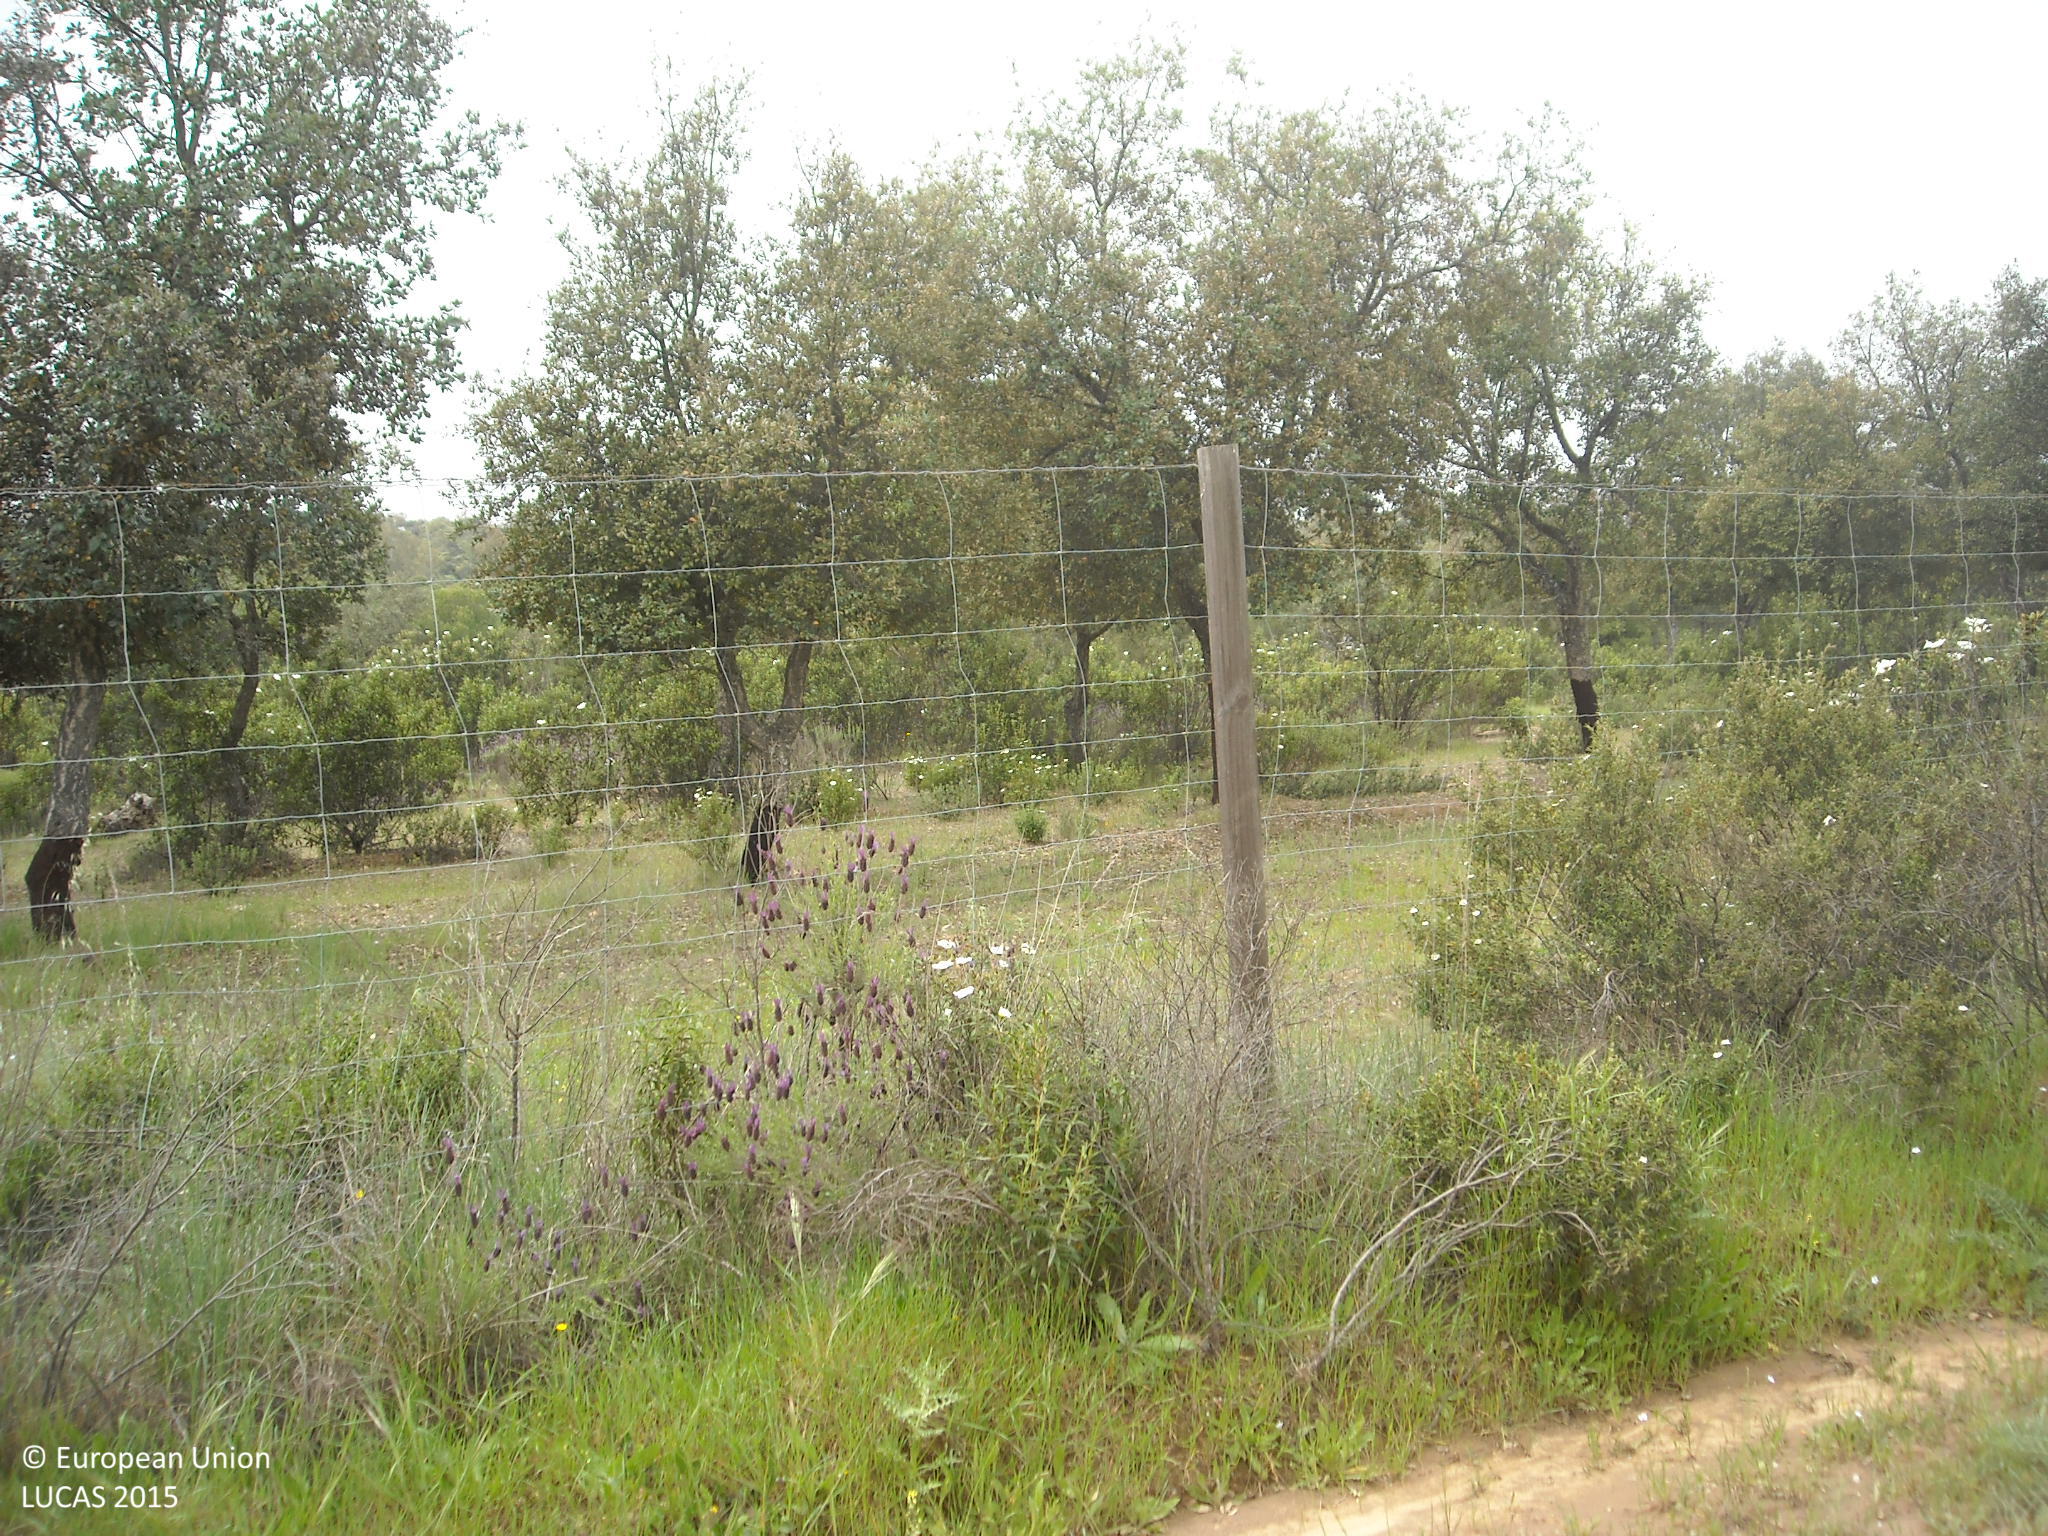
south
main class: Shrubland
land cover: Shrubland with sparse tree cover
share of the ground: 10 - 25 %
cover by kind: herbaceous plants 80 %, shrubs 15 %, broadleaved forest trees 5 %
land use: Forestry
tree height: > 5 m
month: April
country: ES
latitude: 37.8236
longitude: -6.2018
